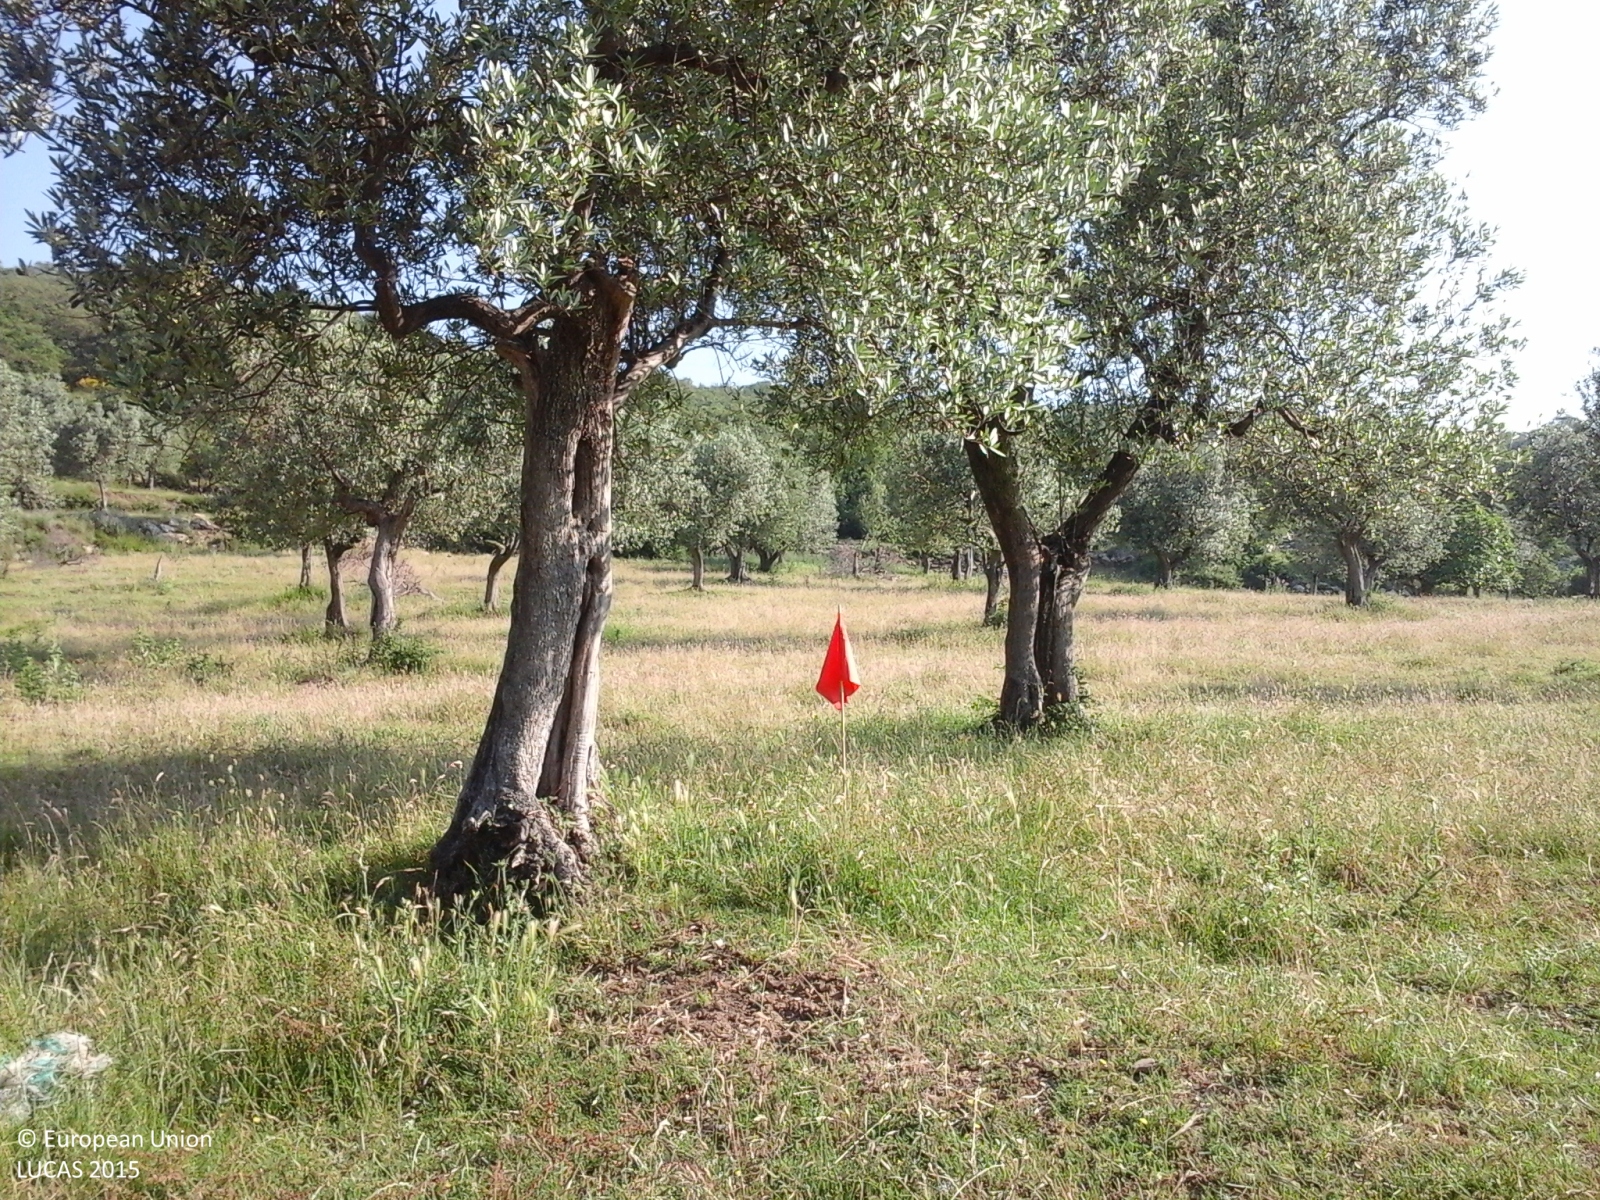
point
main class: Cropland
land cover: Olive groves
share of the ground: 25 - 50 %
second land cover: Grassland without tree/shrub cover
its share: > 75 %
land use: Agriculture (excluding fallow land and kitchen gardens)
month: June
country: IT
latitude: 43.9109
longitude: 11.1800
